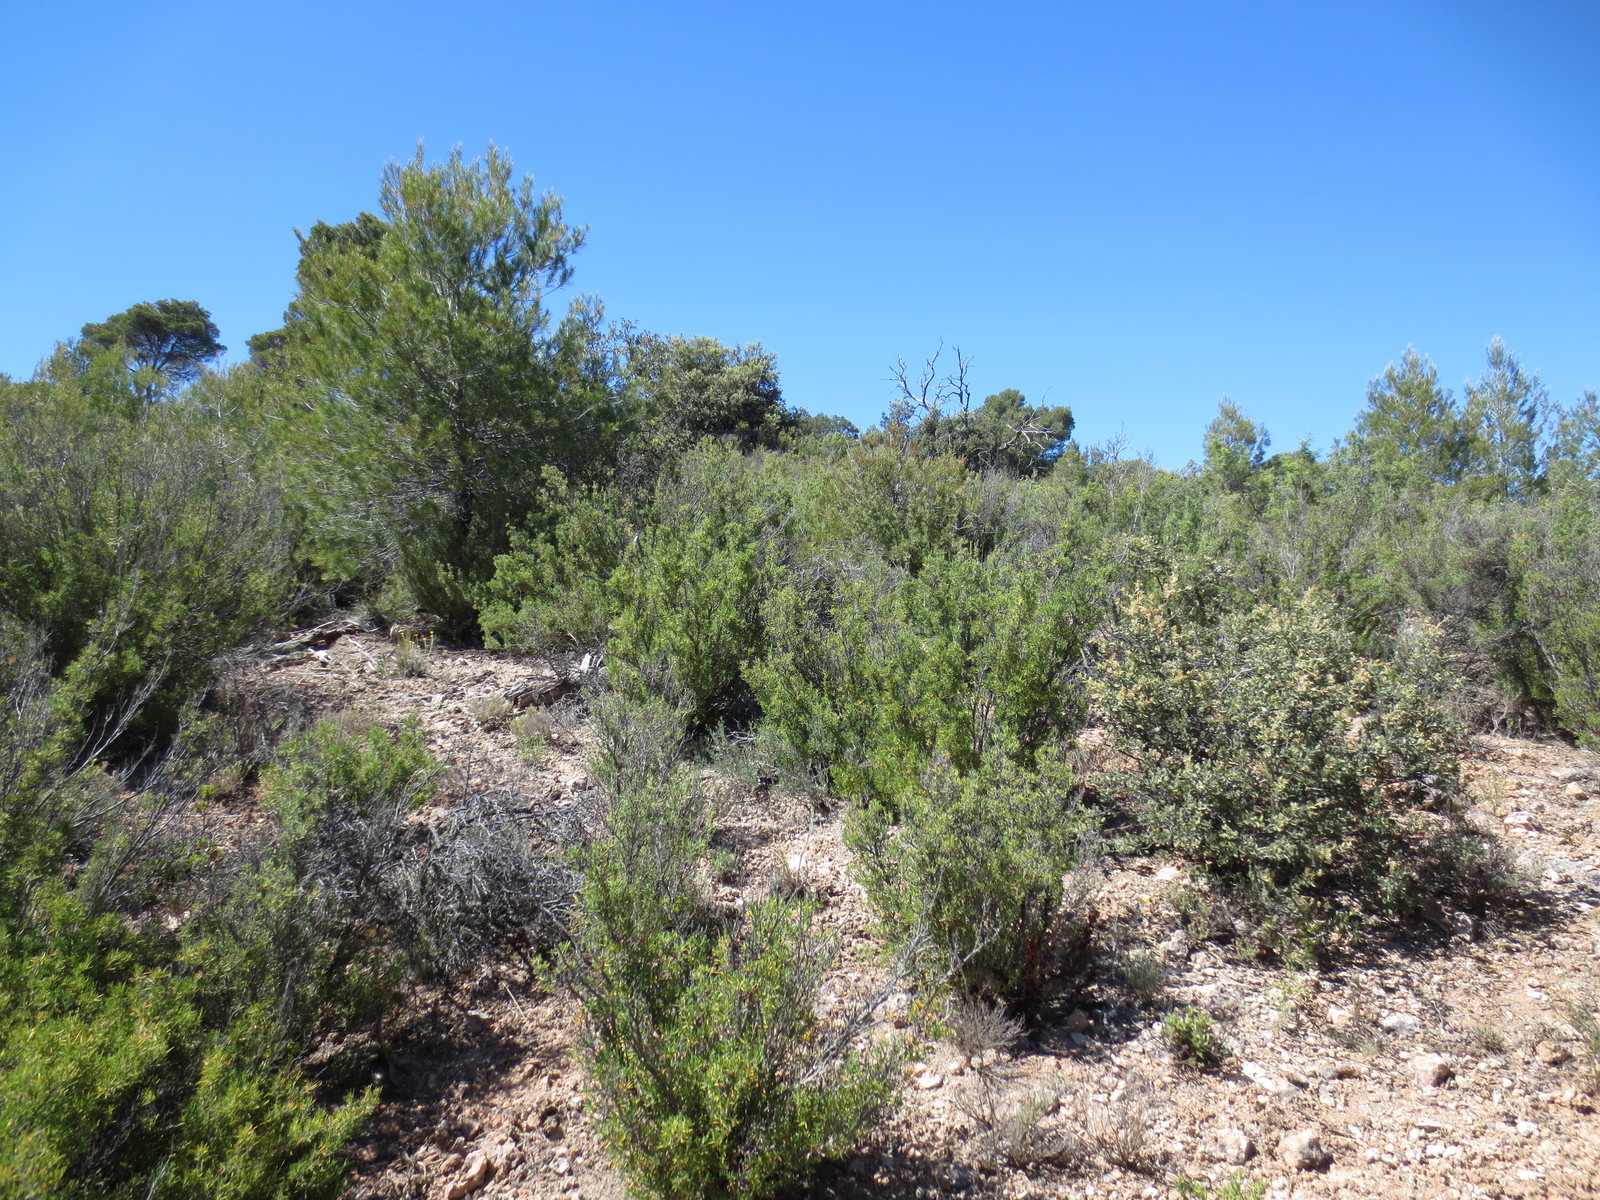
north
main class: Shrubland
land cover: Shrubland with sparse tree cover
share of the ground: > 75 %
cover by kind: shrubs 75 %, unconsolidated bare surface 20 %, coniferous forest trees 5 %
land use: Semi-natural and natural areas not in use
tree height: < 5 m
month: May
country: ES
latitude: 40.2240
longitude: -2.8458
